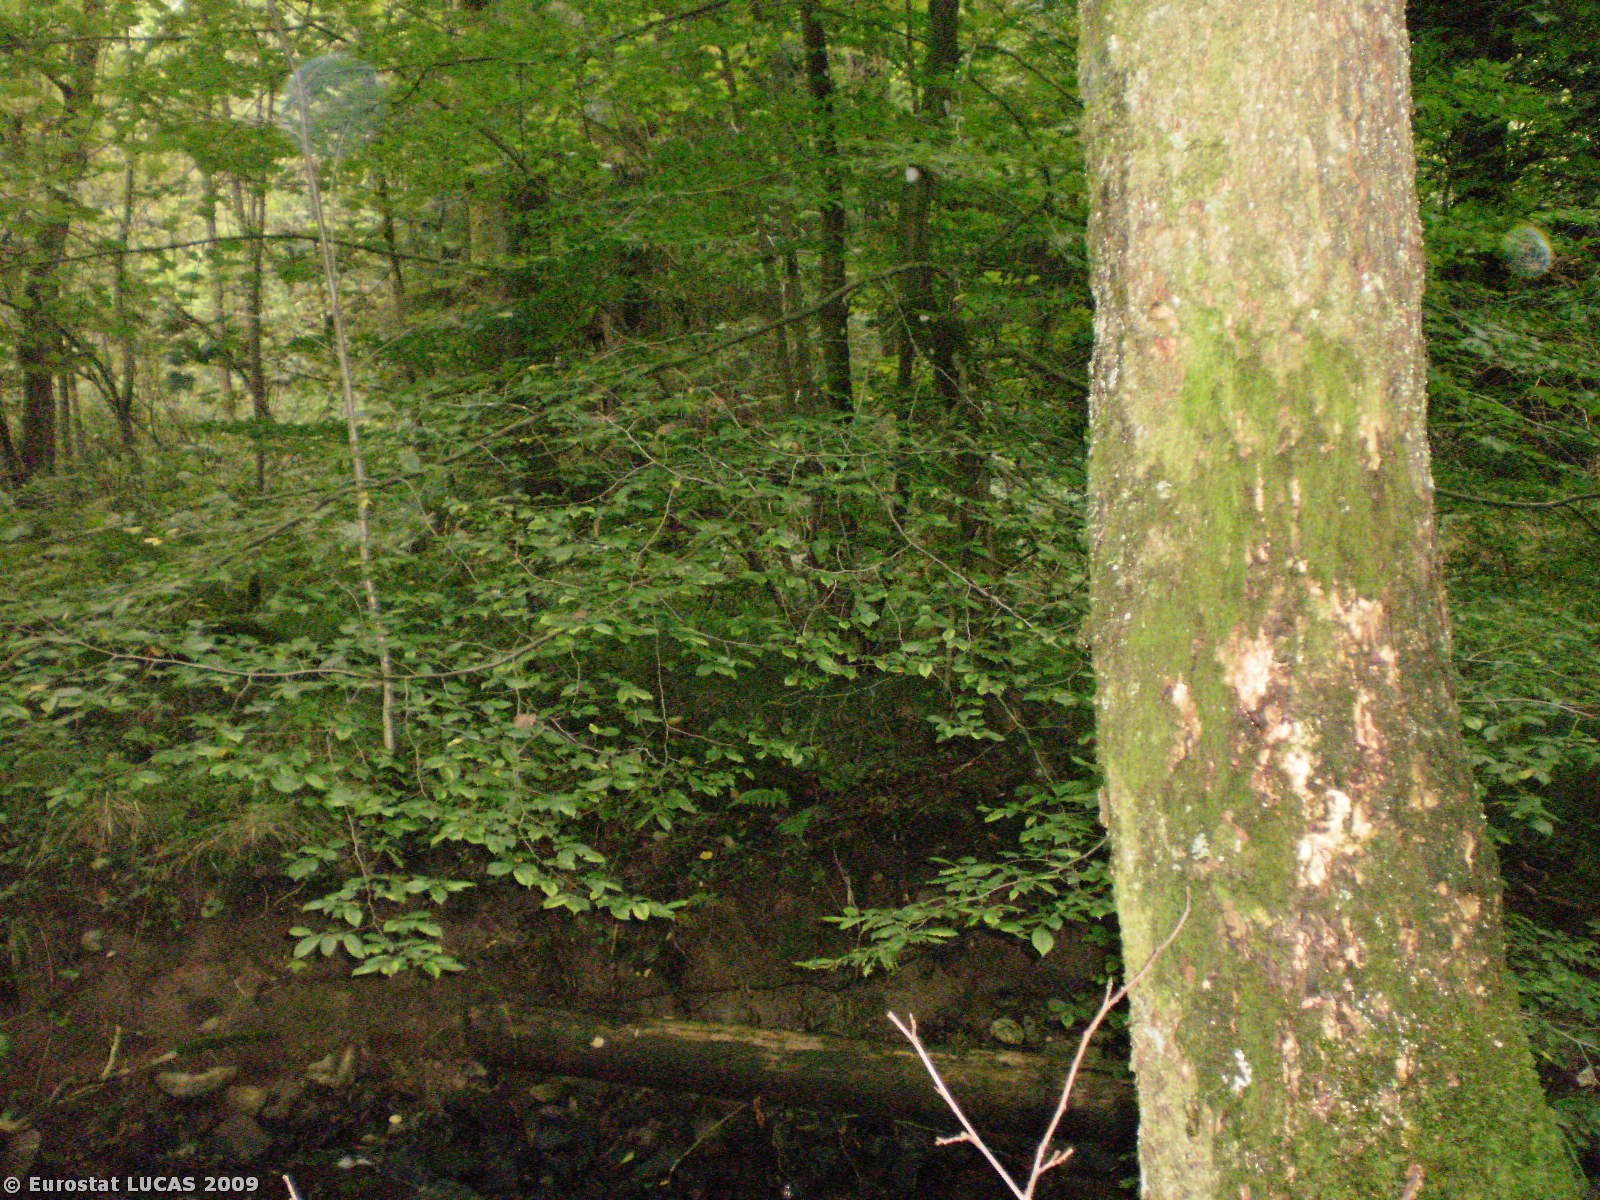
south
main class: Woodland
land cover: Mixed woodland
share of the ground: > 75 %
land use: Nature reserves
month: September
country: BE
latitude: 50.2438
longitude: 5.6094
